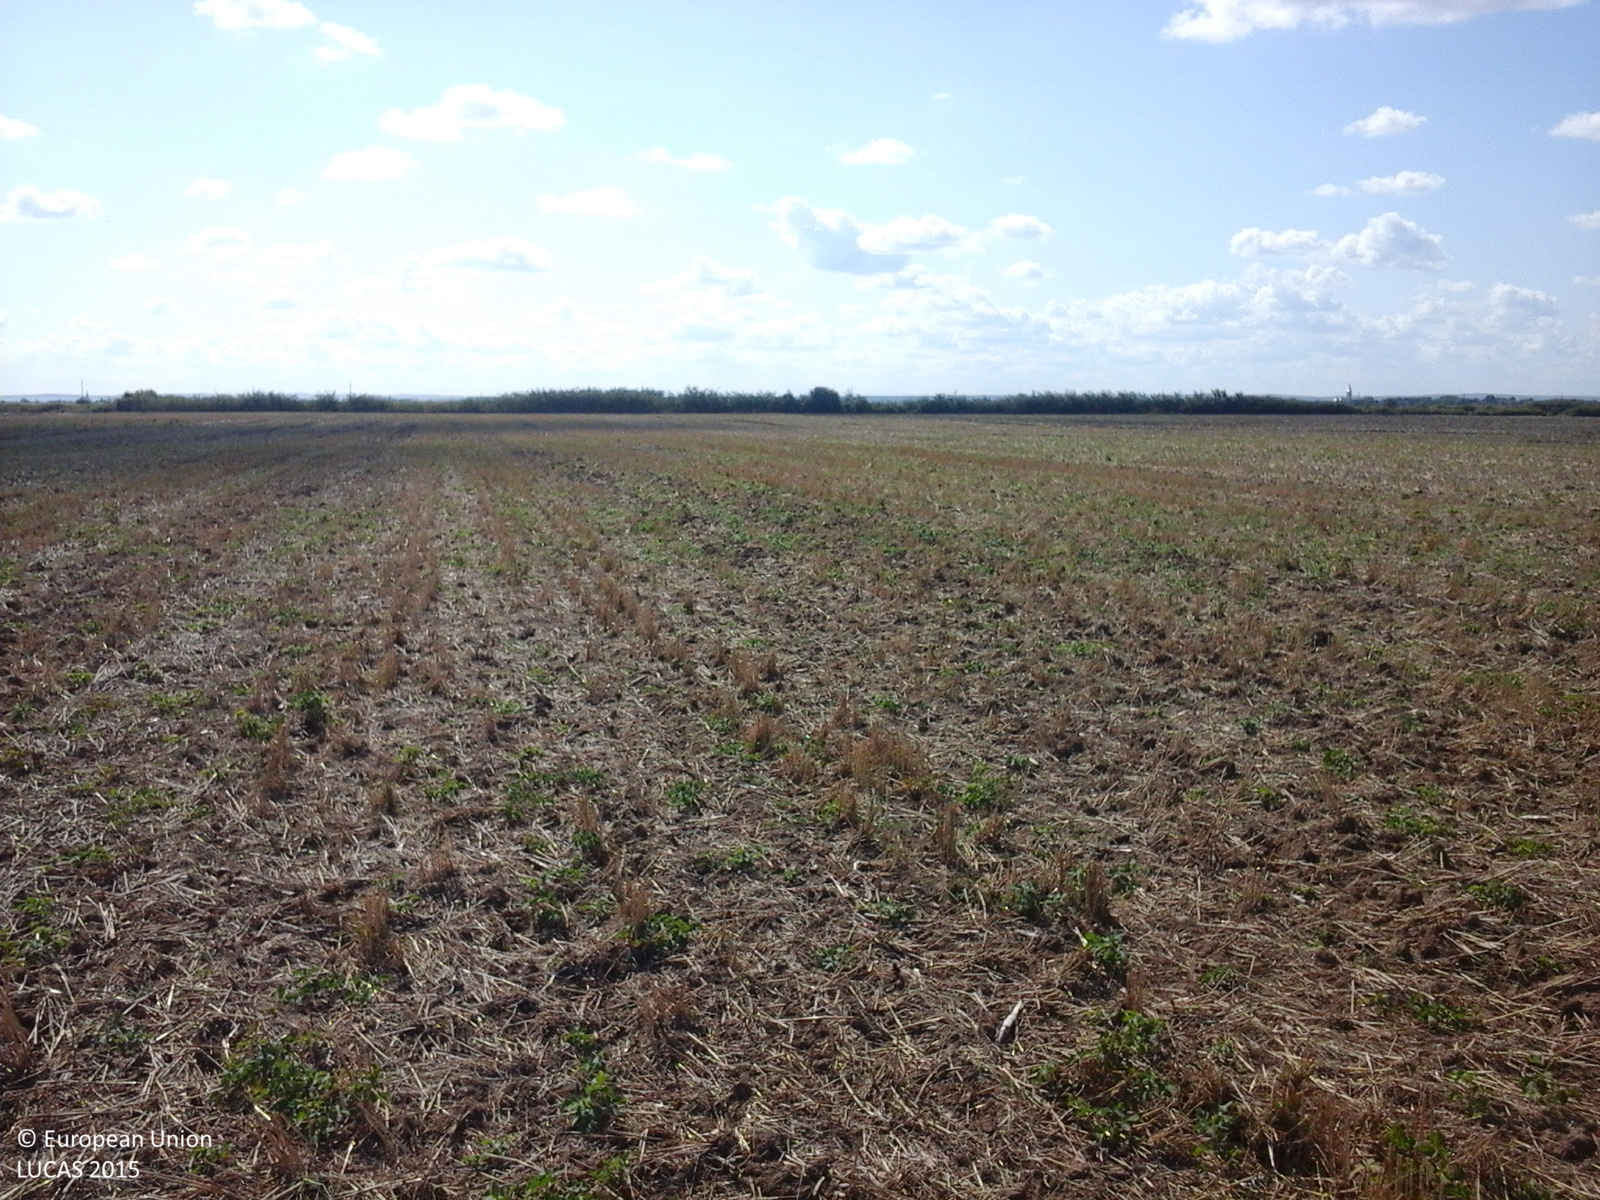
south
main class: Cropland
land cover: Durum wheat
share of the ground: 25 - 50 %
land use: Agriculture (excluding fallow land and kitchen gardens)
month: September
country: RO
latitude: 47.5938
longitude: 22.7080
